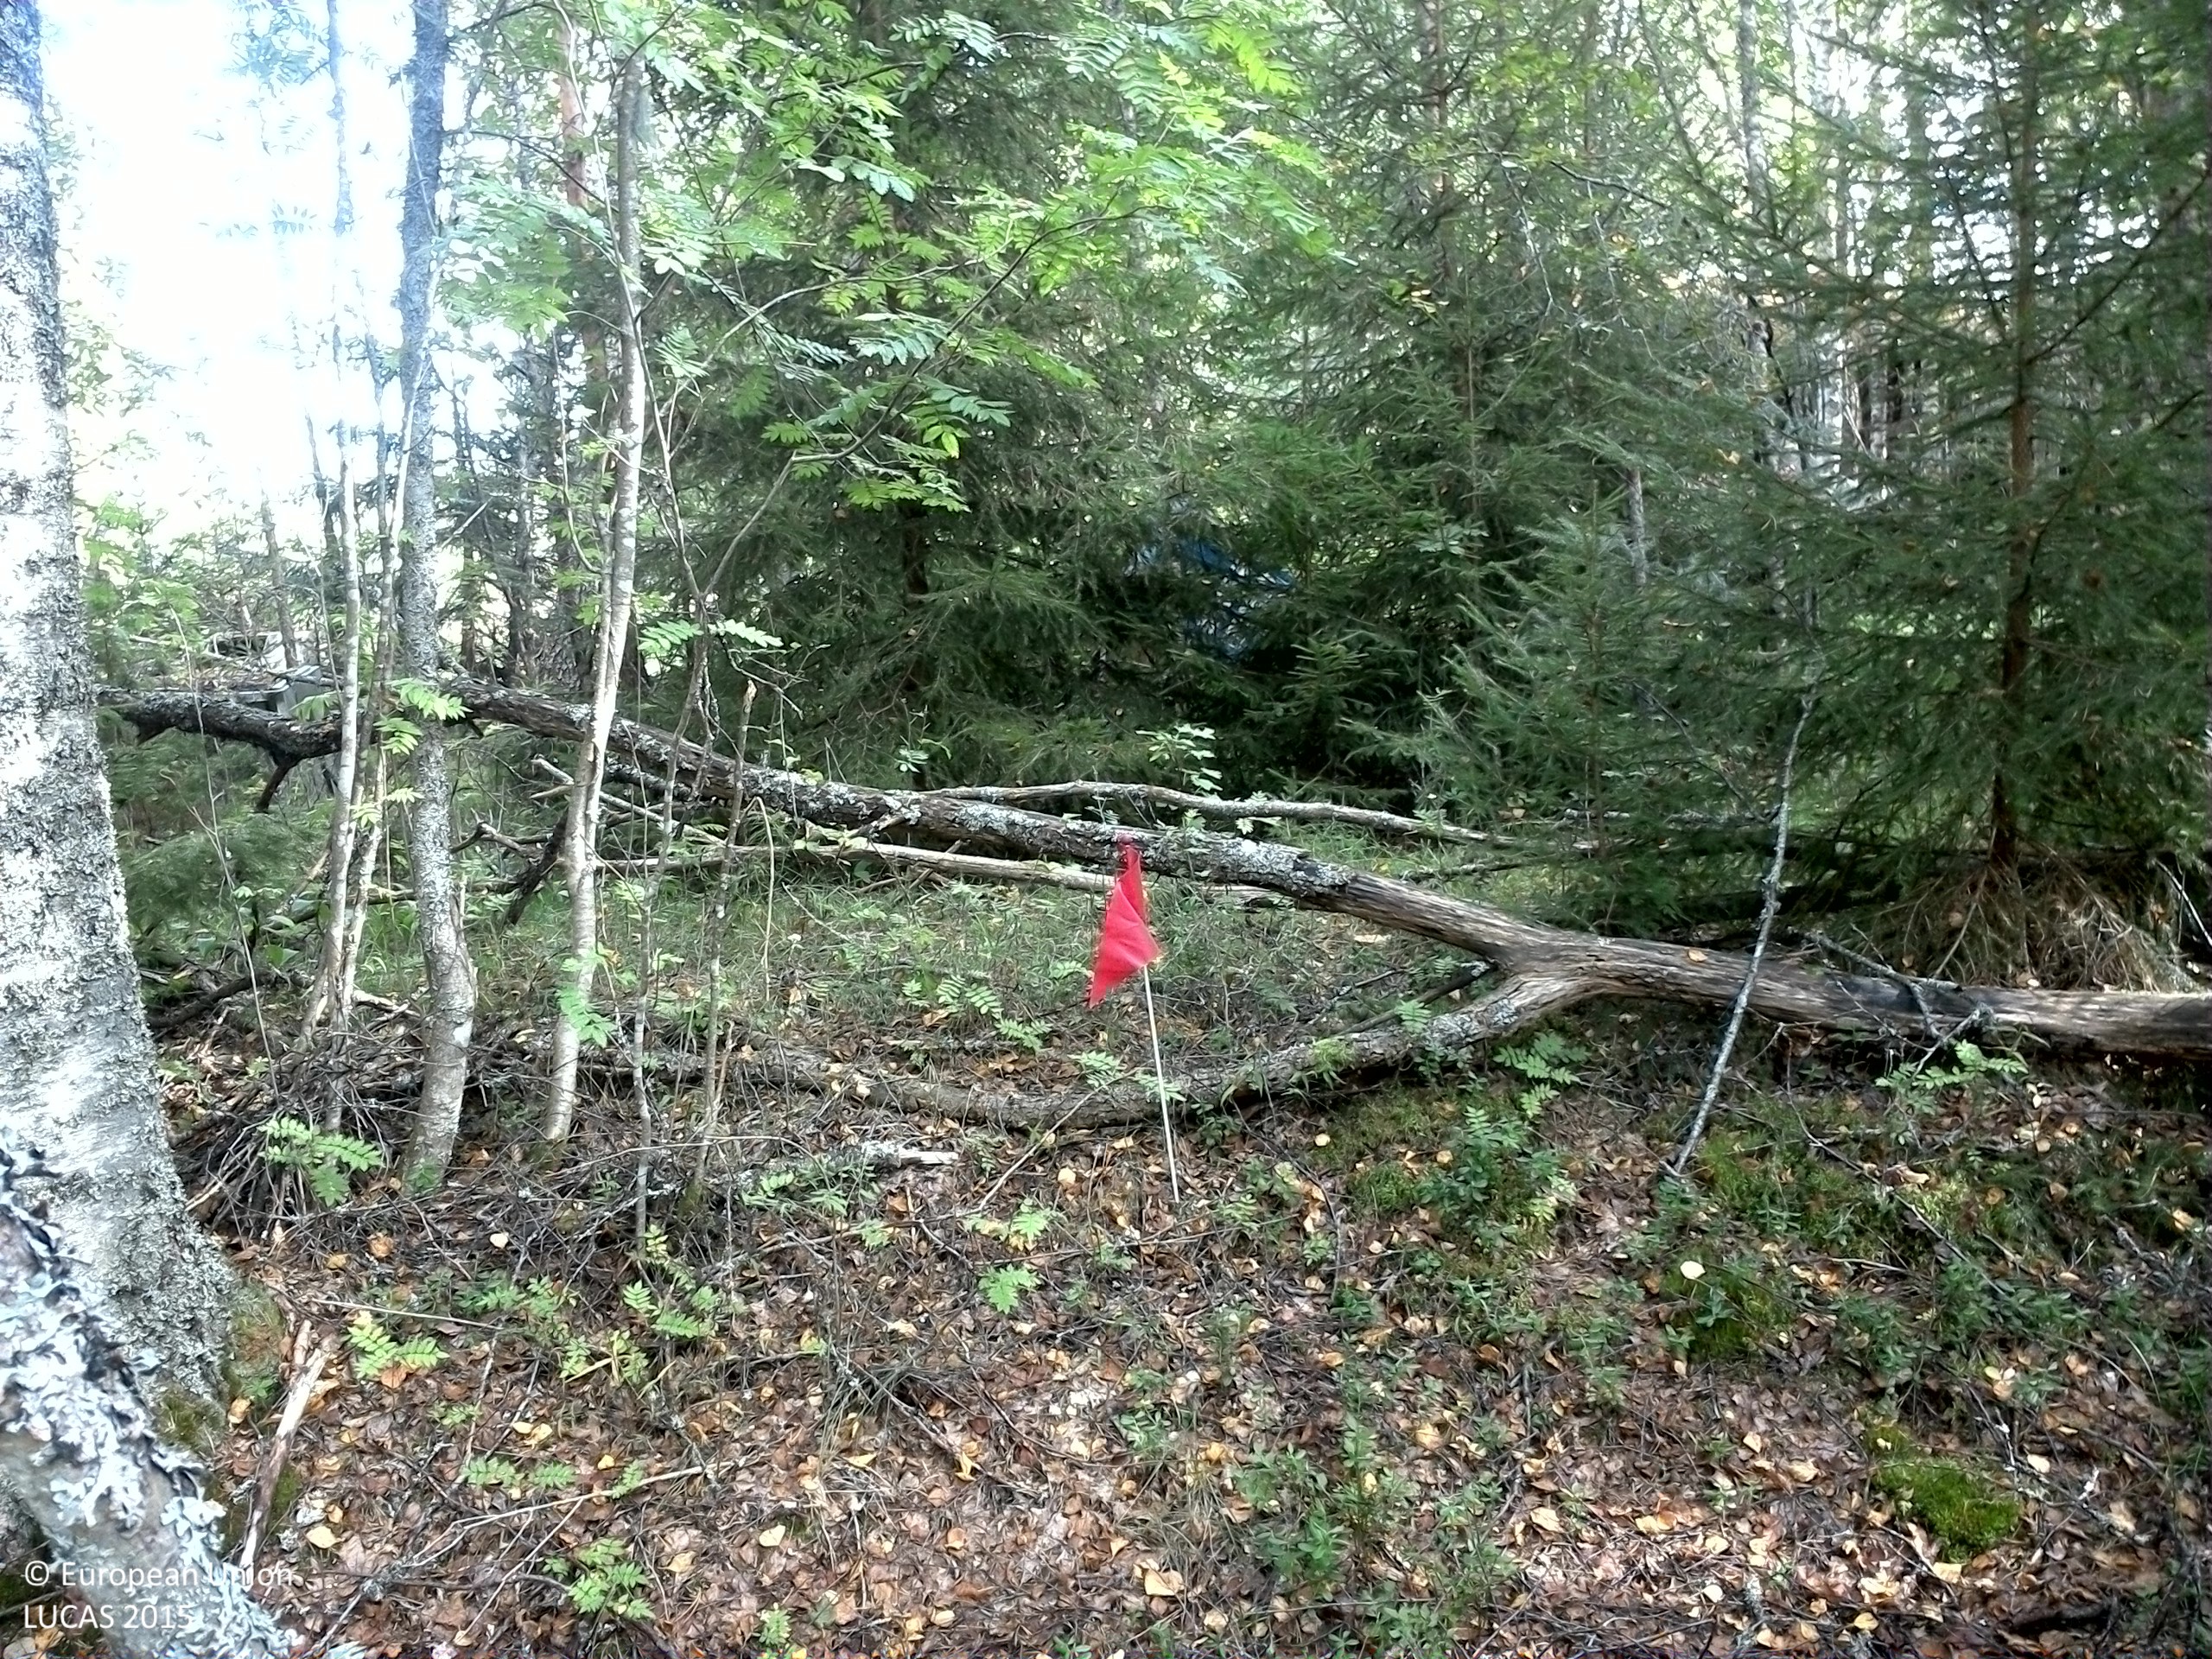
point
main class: Woodland
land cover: Pine dominated mixed woodland
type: boreal forest
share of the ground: 50 - 75 %
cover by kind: coniferous forest trees 50 %, broadleaved forest trees 20 %, shrubs 20 %, lichens and mosses 10 %
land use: Forestry
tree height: > 5 m
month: September
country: SE
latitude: 59.7948
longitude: 13.5018
